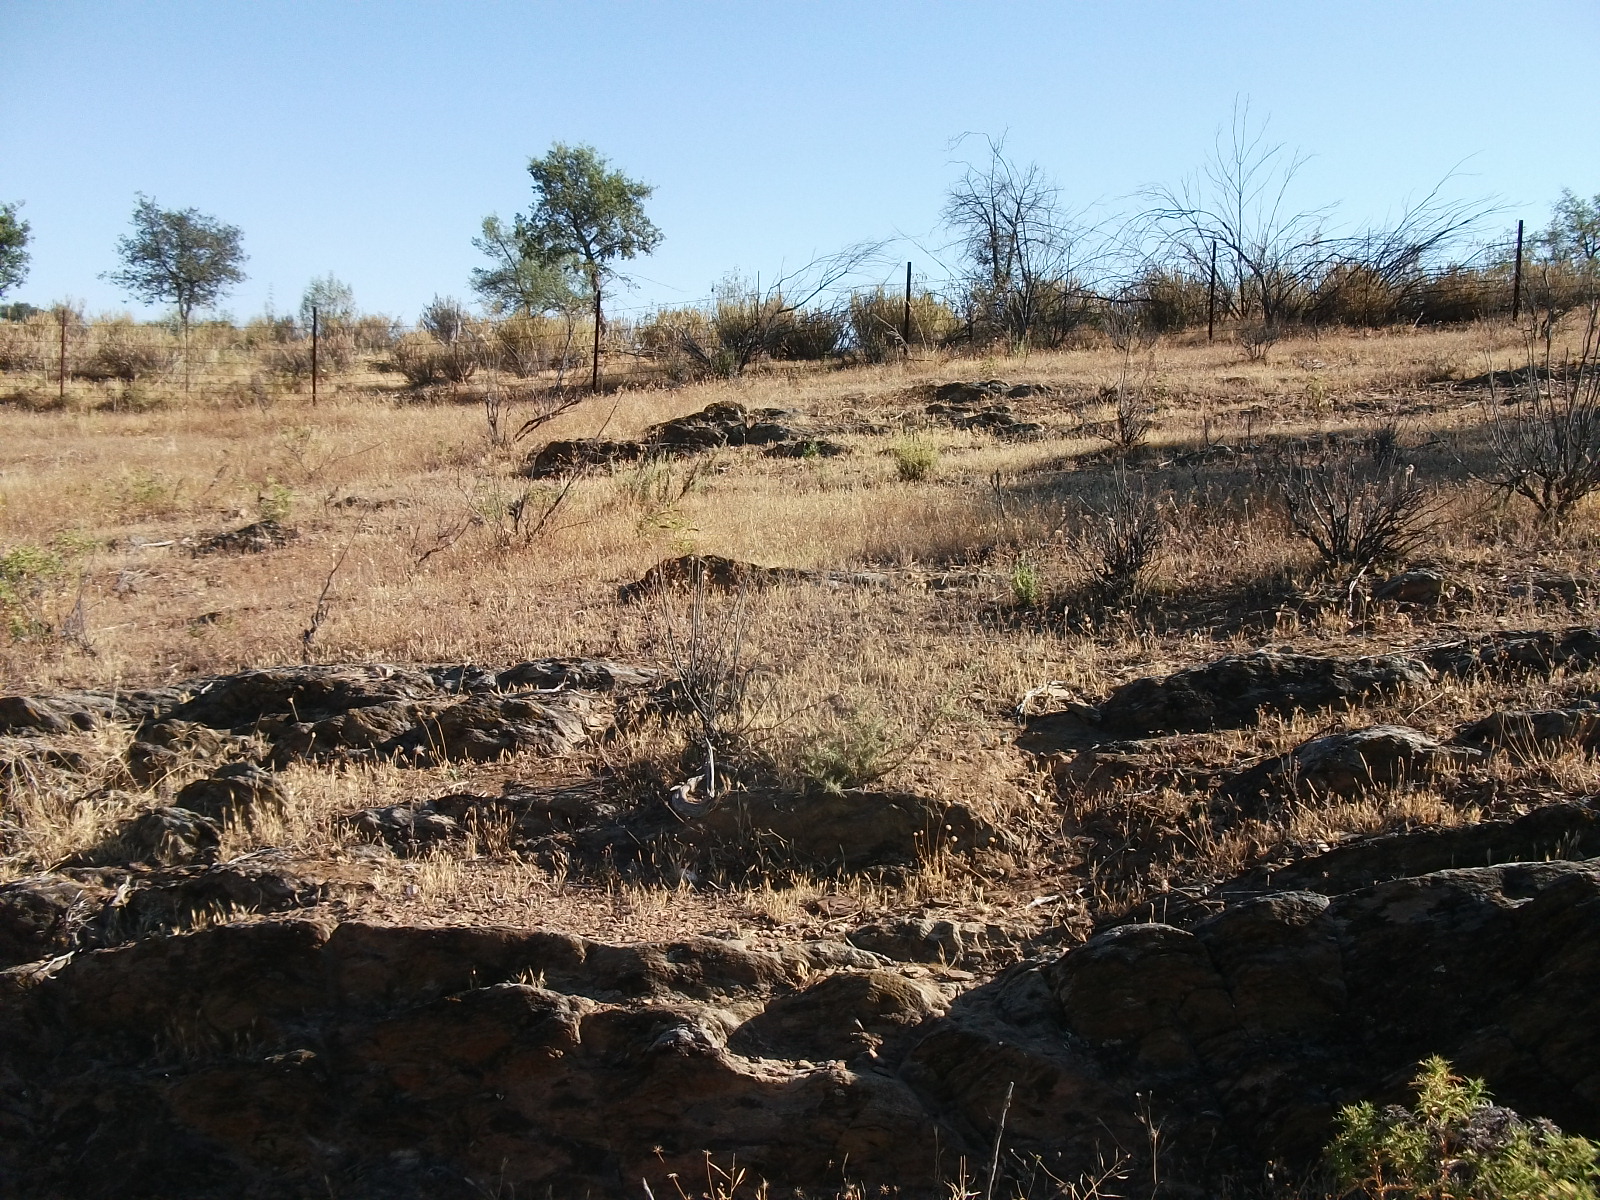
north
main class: Grassland
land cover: Grassland with sparse tree/shrub cover
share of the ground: > 75 %
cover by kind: herbaceous plants 95 %, broadleaved forest trees 5 %
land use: Agriculture (excluding fallow land and kitchen gardens)
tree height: < 5 m
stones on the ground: > 50 %
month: June
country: ES
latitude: 37.6392
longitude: -7.0352
